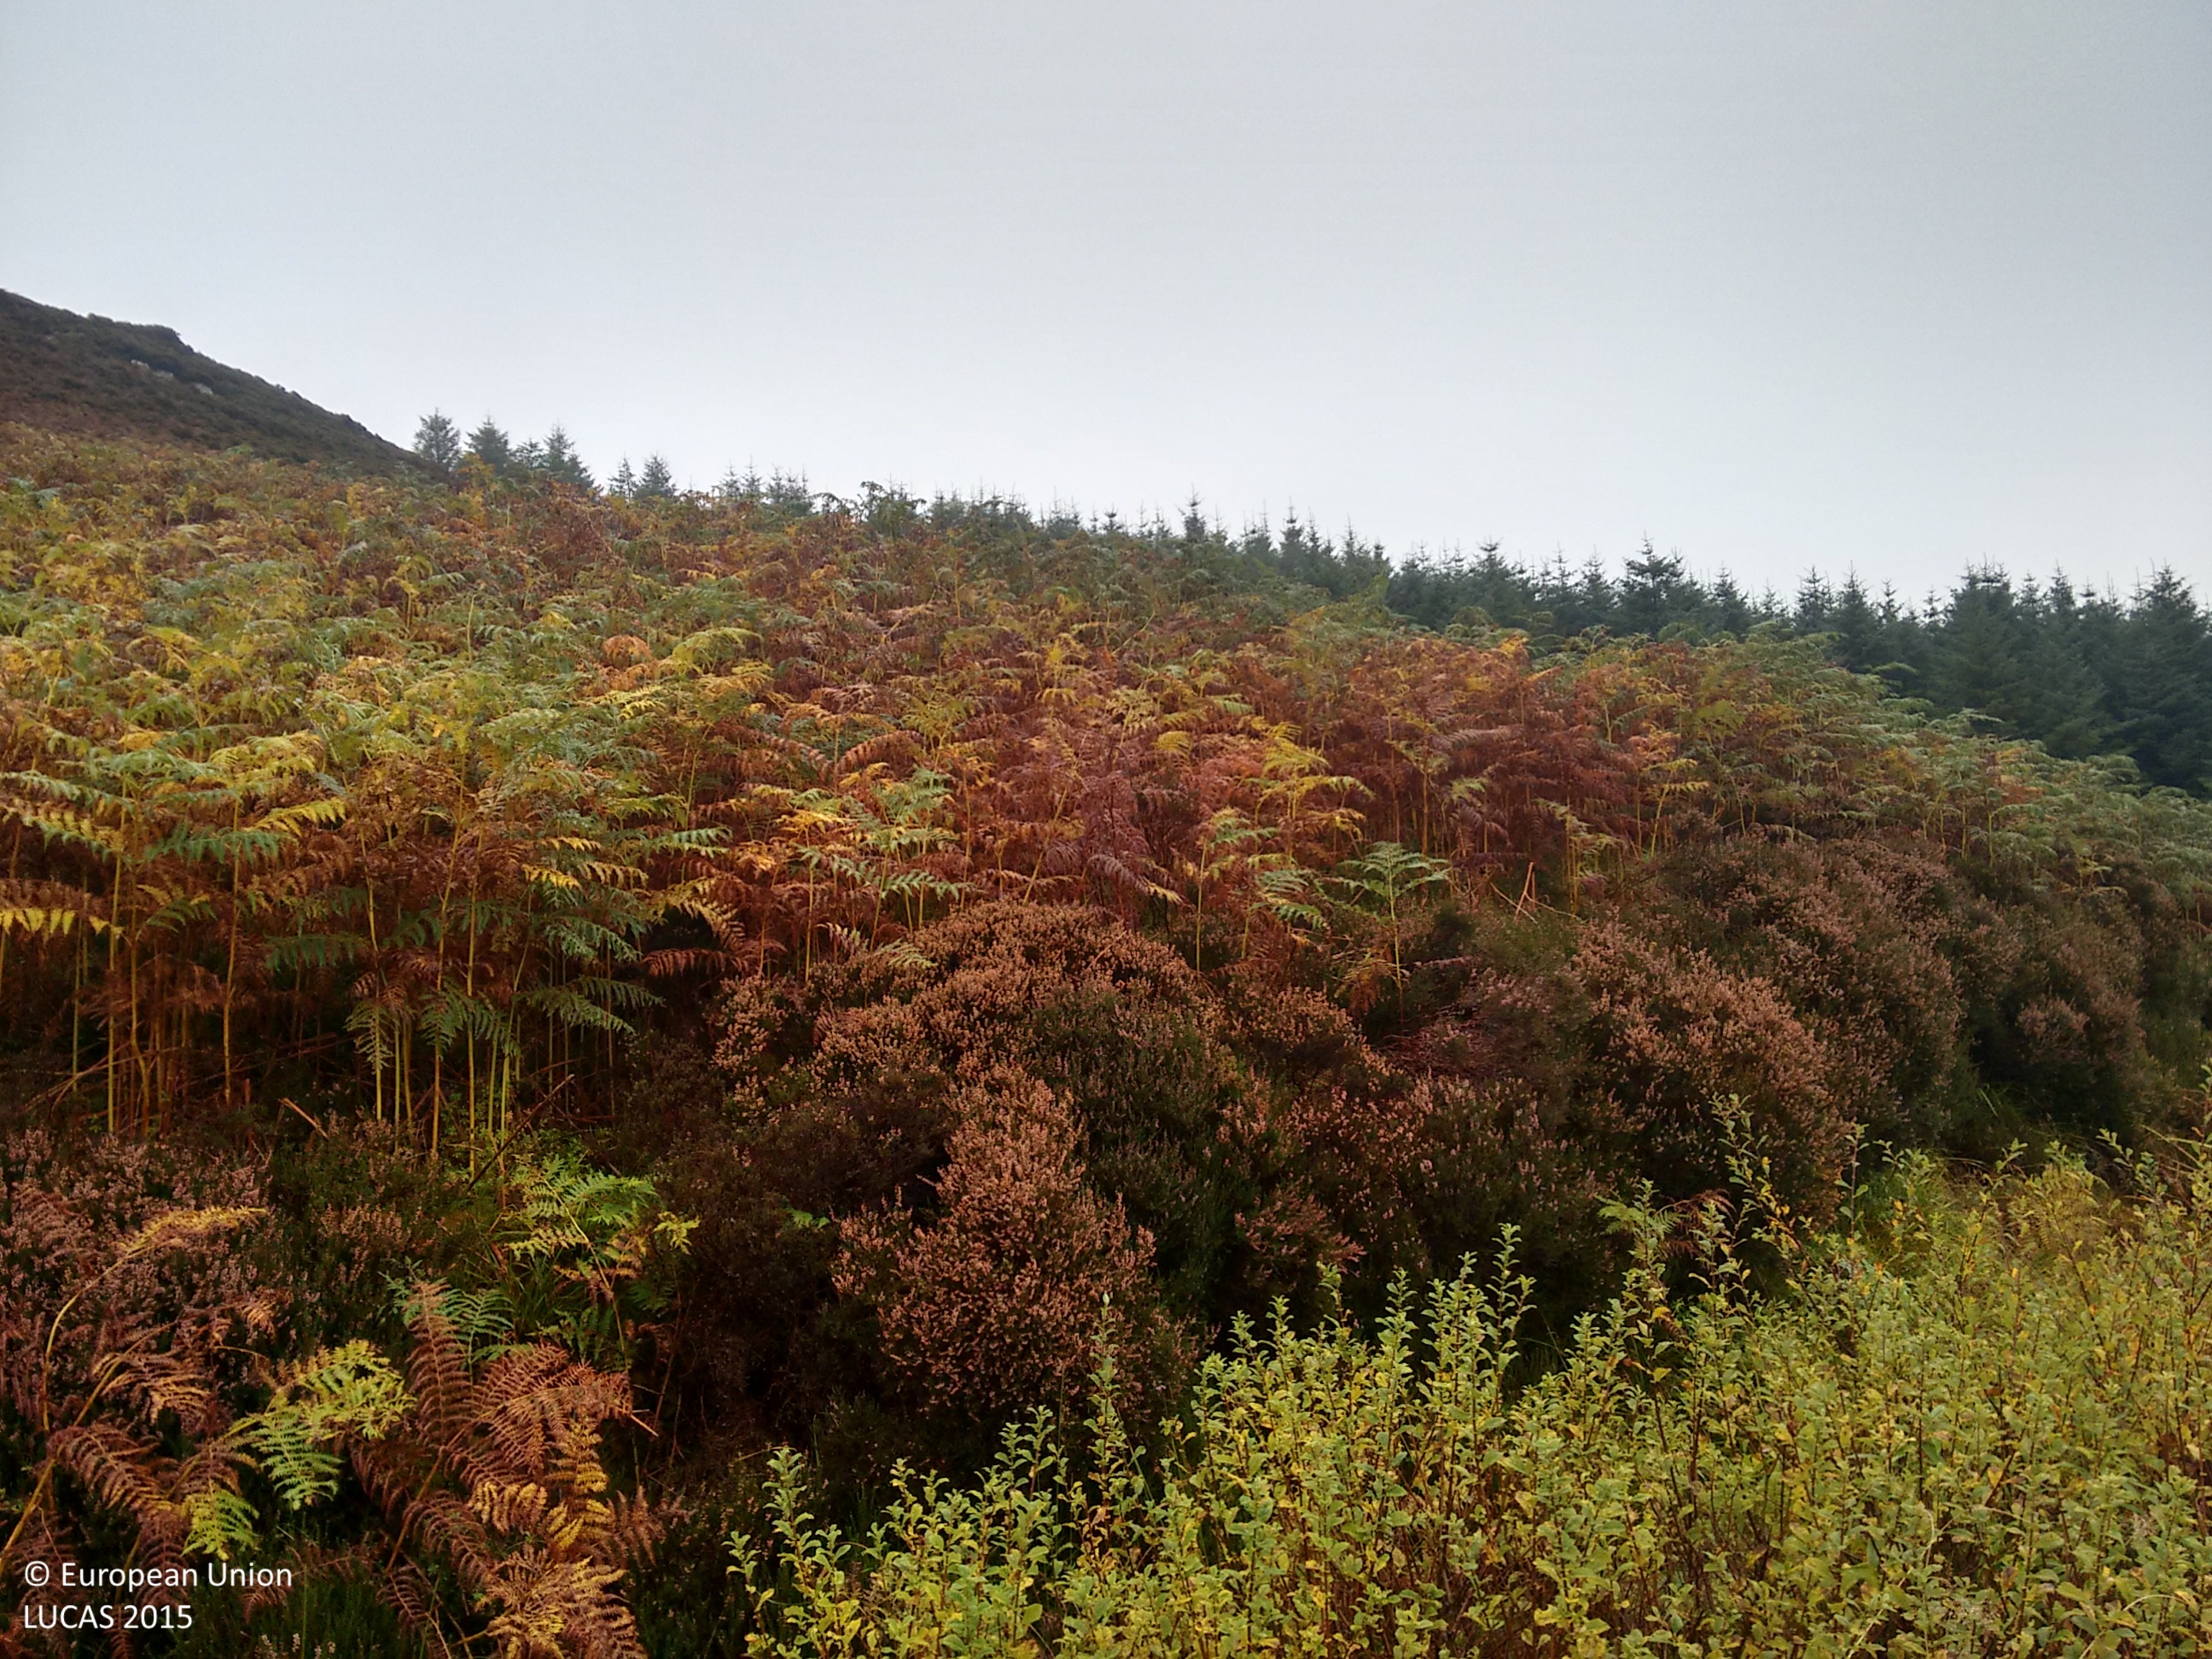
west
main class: Shrubland
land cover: Shrubland without tree cover
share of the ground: > 75 %
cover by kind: shrubs 80 %, herbaceous plants 20 %
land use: Semi-natural and natural areas not in use
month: October
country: GB
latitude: 55.6220
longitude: -6.2302
